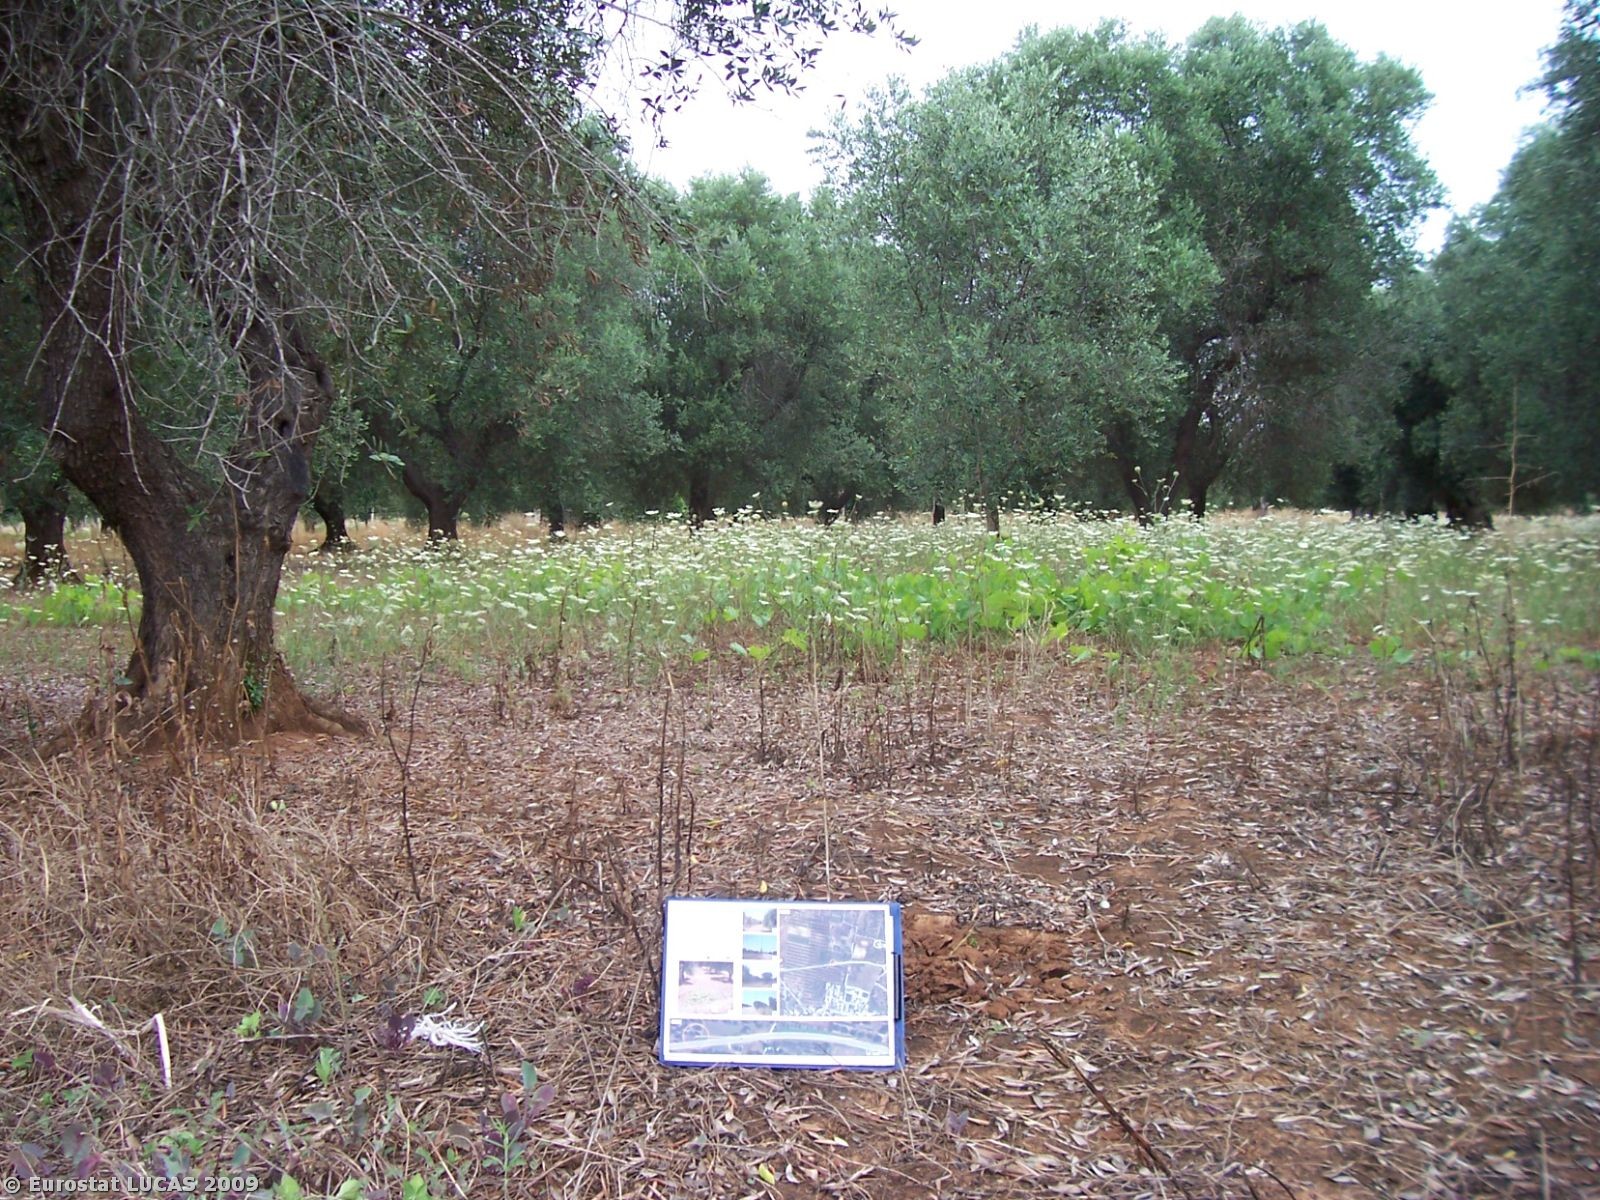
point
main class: Cropland
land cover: Olive groves
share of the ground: 25 - 50 %
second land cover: Spontaneously vegetated surfaces
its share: > 75 %
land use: Agriculture (excluding fallow land and kitchen gardens)
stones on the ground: < 10 %
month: June
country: IT
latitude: 40.3615
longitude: 17.4995
